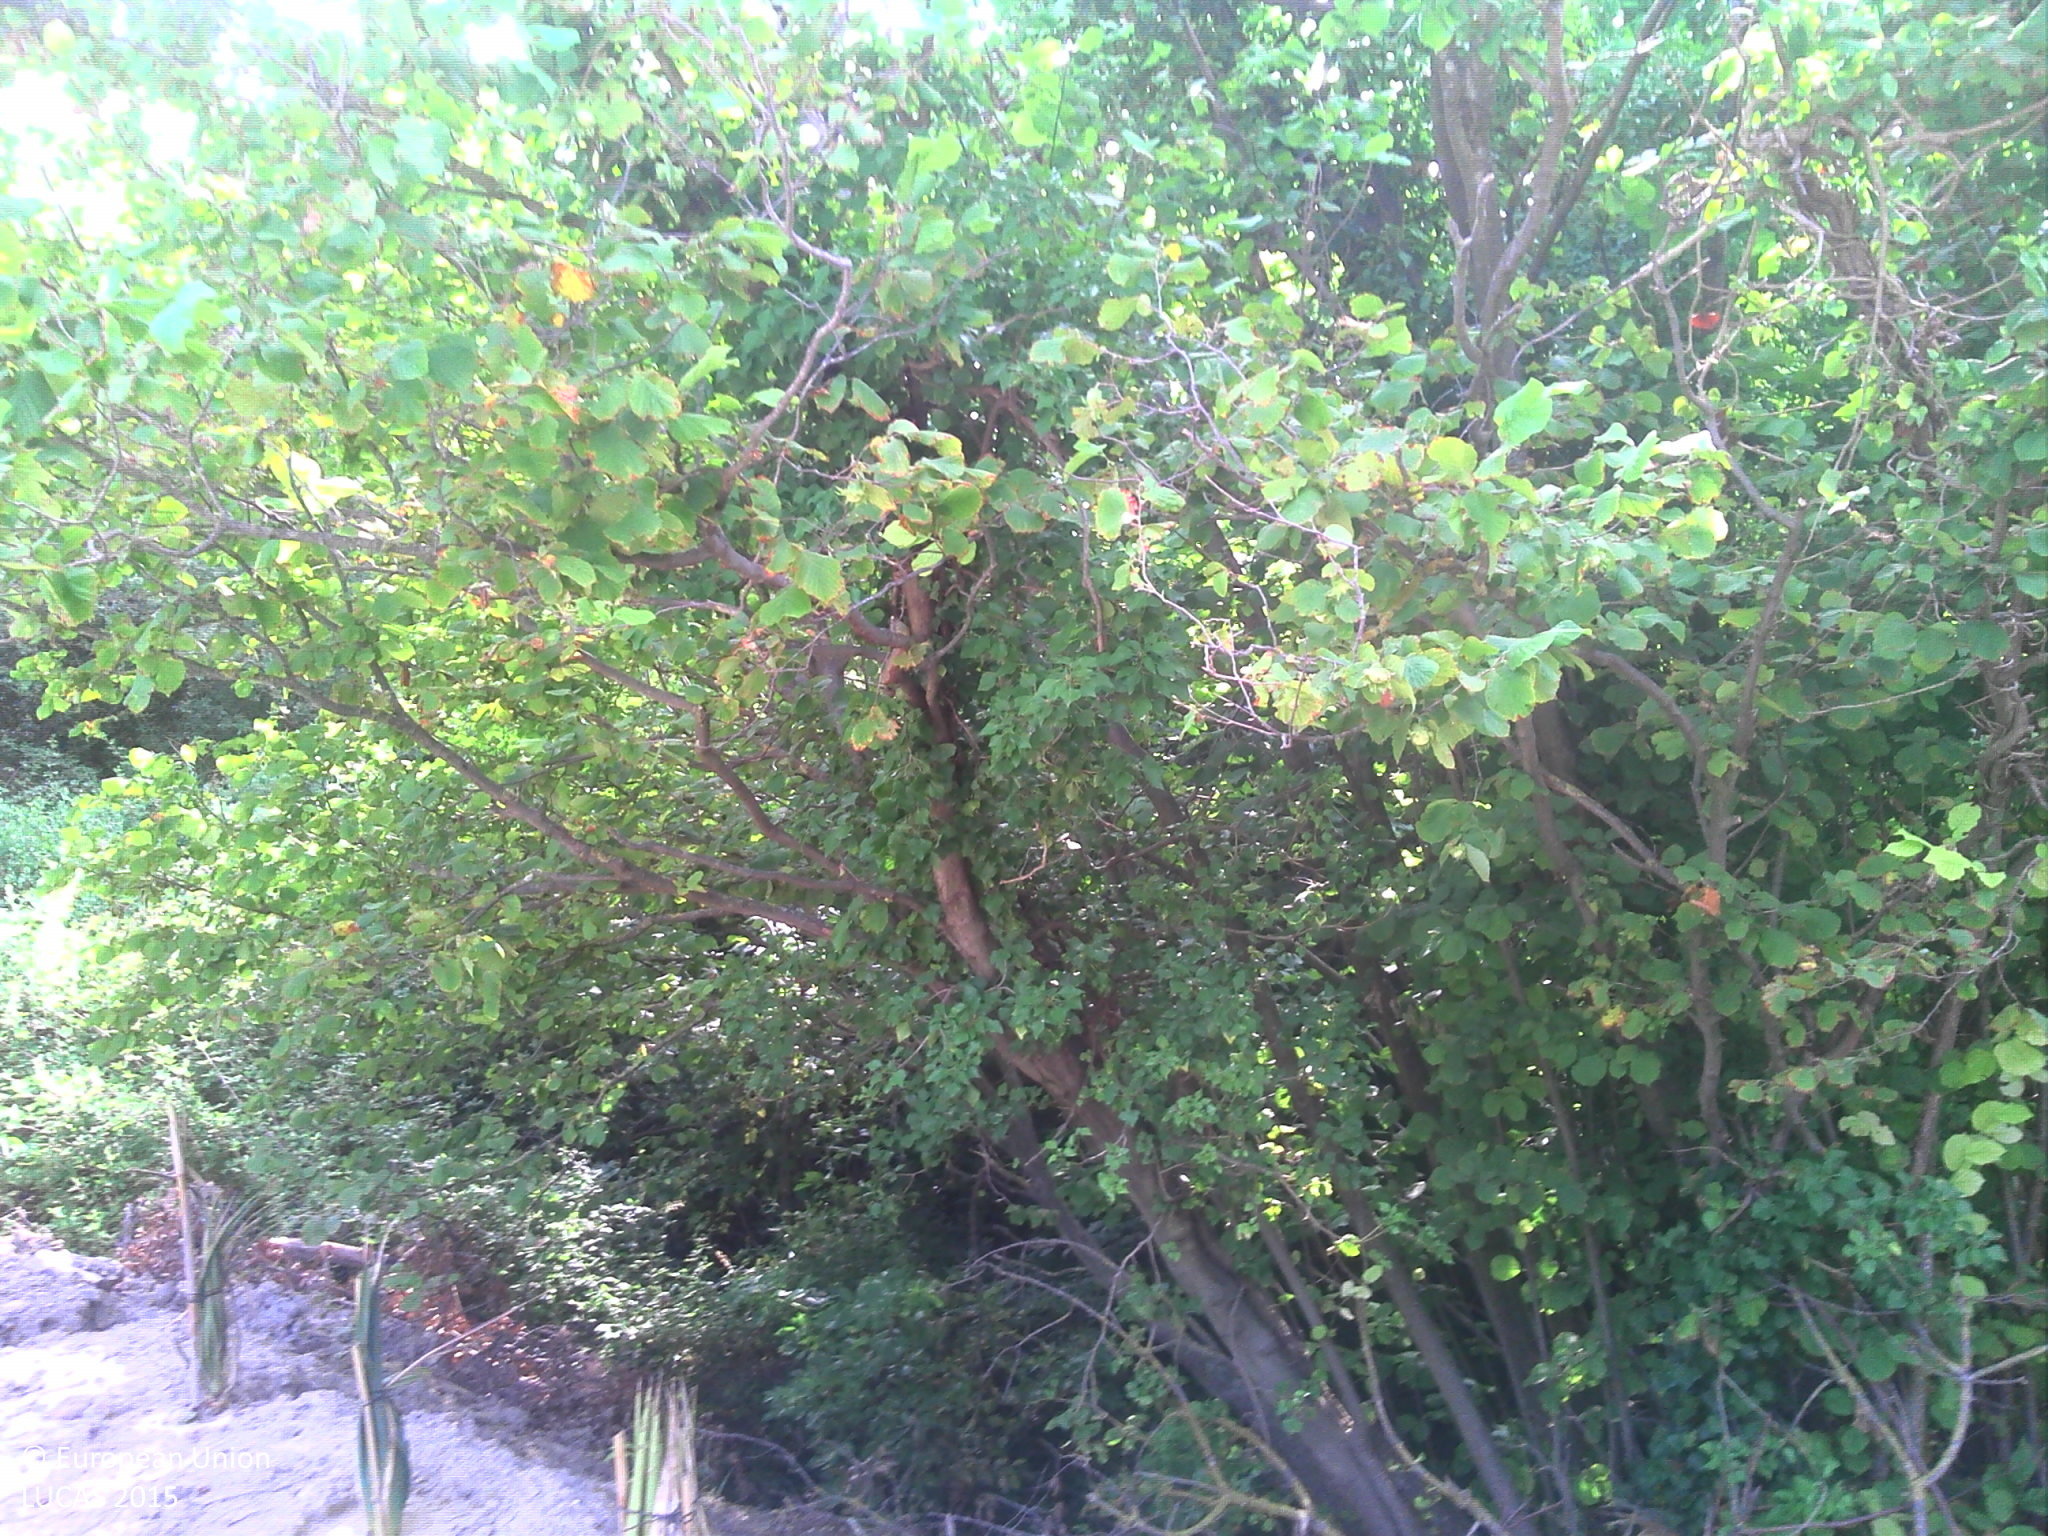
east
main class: Woodland
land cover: Broadleaved woodland
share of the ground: > 75 %
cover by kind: broadleaved forest trees 80 %
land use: Semi-natural and natural areas not in use
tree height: < 5 m
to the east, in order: Broadleaved woodland; Grassland without tree/shrub cover; Broadleaved woodland; Rivers and streams; Broadleaved woodland
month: July
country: FR
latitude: 43.6176
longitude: 5.0406
